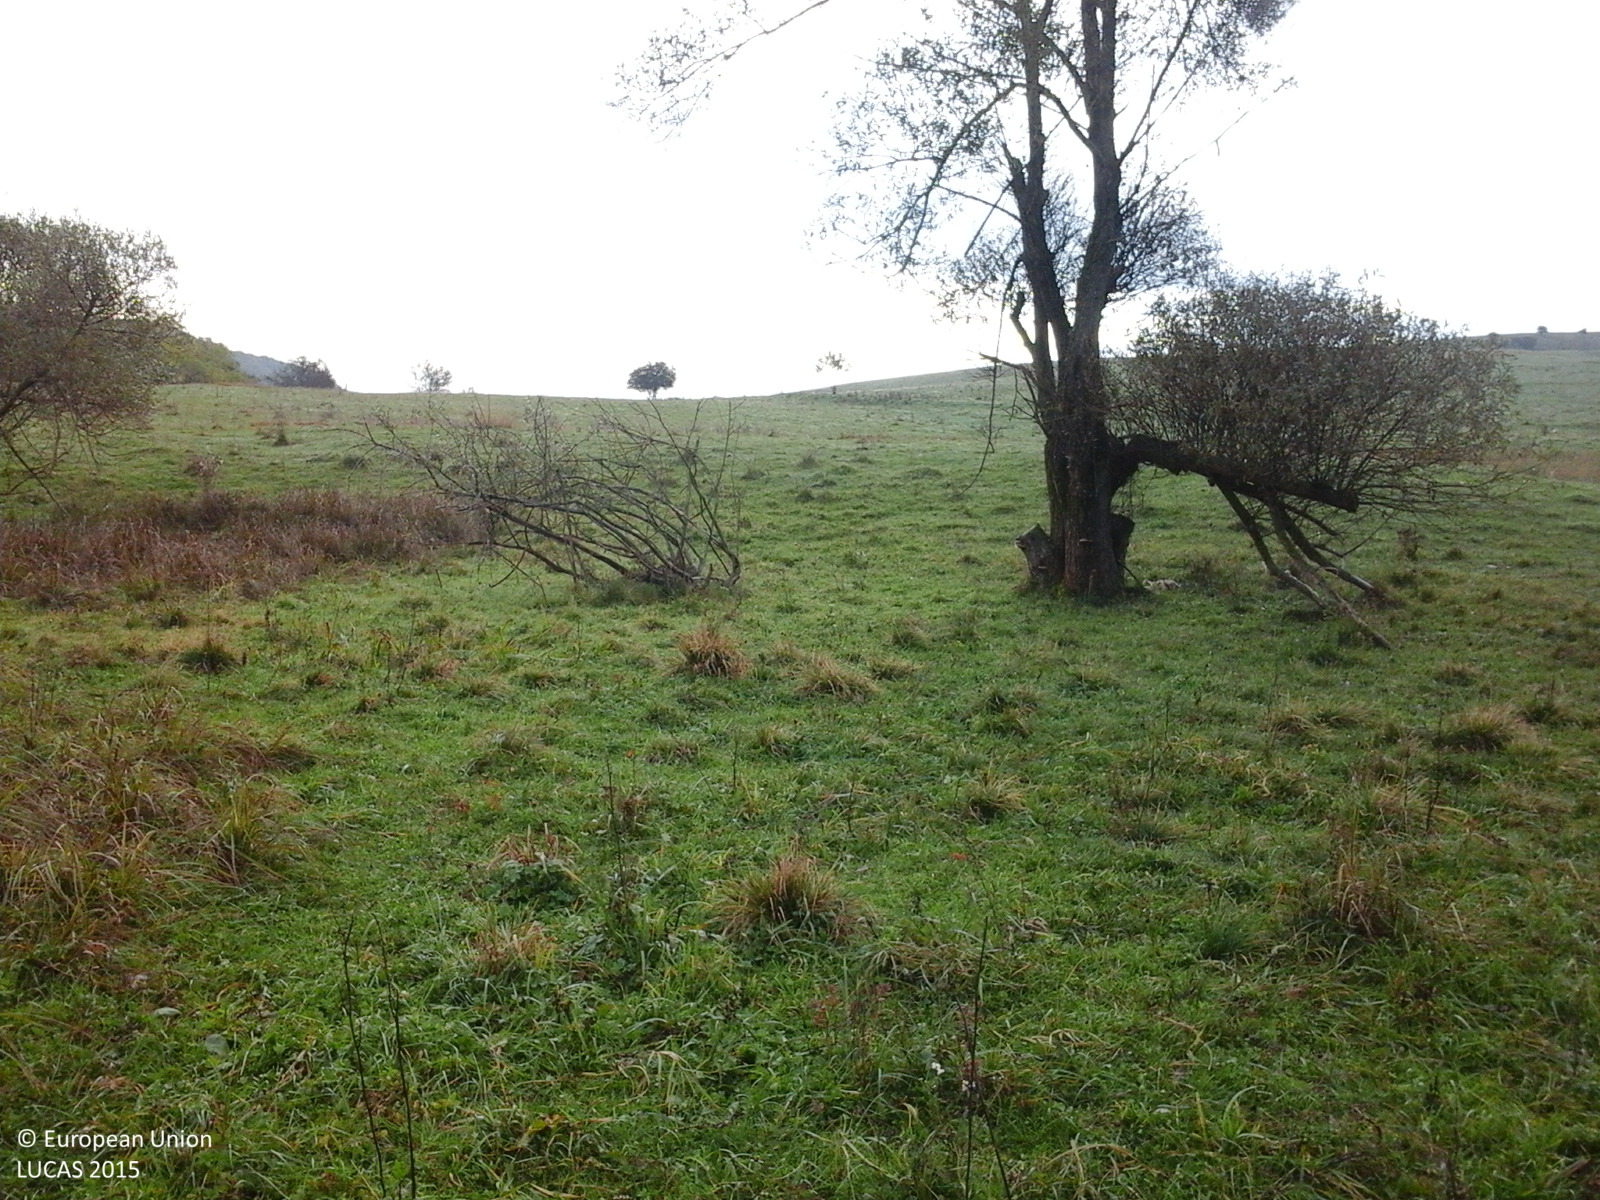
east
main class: Grassland
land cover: Grassland with sparse tree/shrub cover
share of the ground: > 75 %
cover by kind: herbaceous plants 95 %, broadleaved forest trees 5 %
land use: Agriculture (excluding fallow land and kitchen gardens)
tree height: > 5 m
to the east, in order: Grassland with sparse tree/shrub cover; Grassland without tree/shrub cover; Single bushes/trees; Grassland without tree/shrub cover
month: October
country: RO
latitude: 46.0031
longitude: 24.7183
